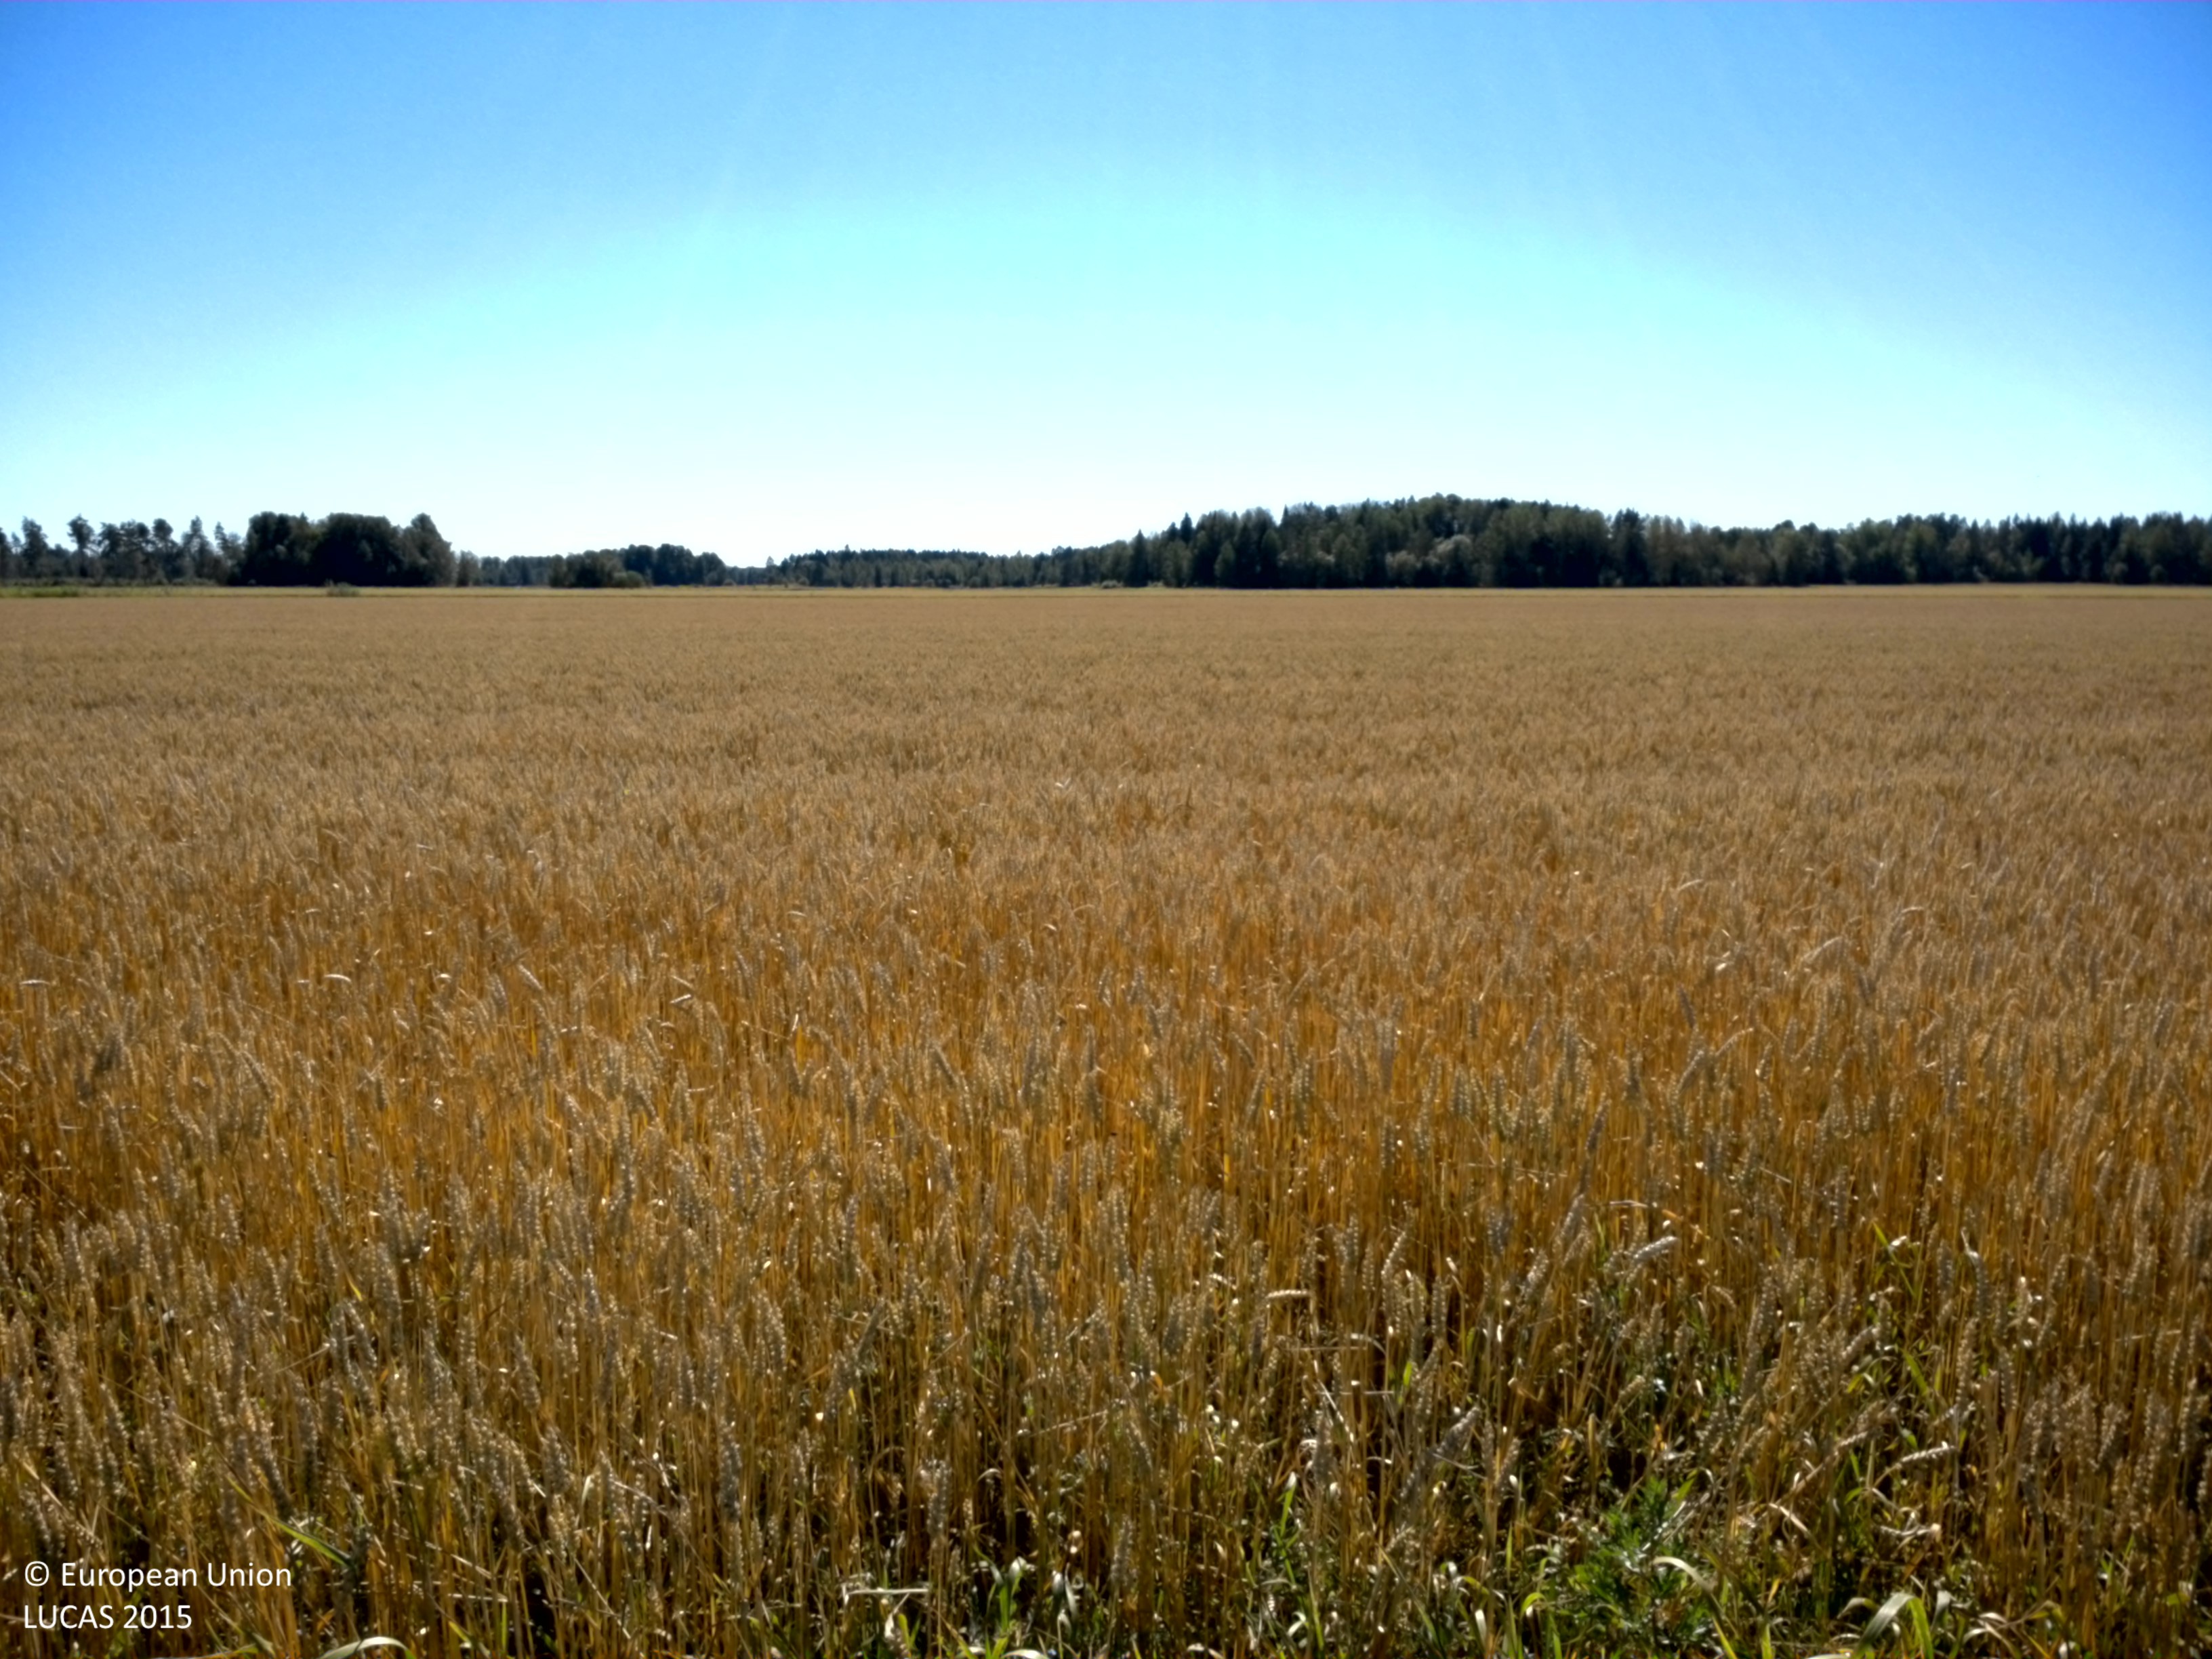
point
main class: Cropland
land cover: Common wheat
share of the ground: > 75 %
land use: Agriculture (excluding fallow land and kitchen gardens)
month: August
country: SE
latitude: 60.1301
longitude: 17.0657
